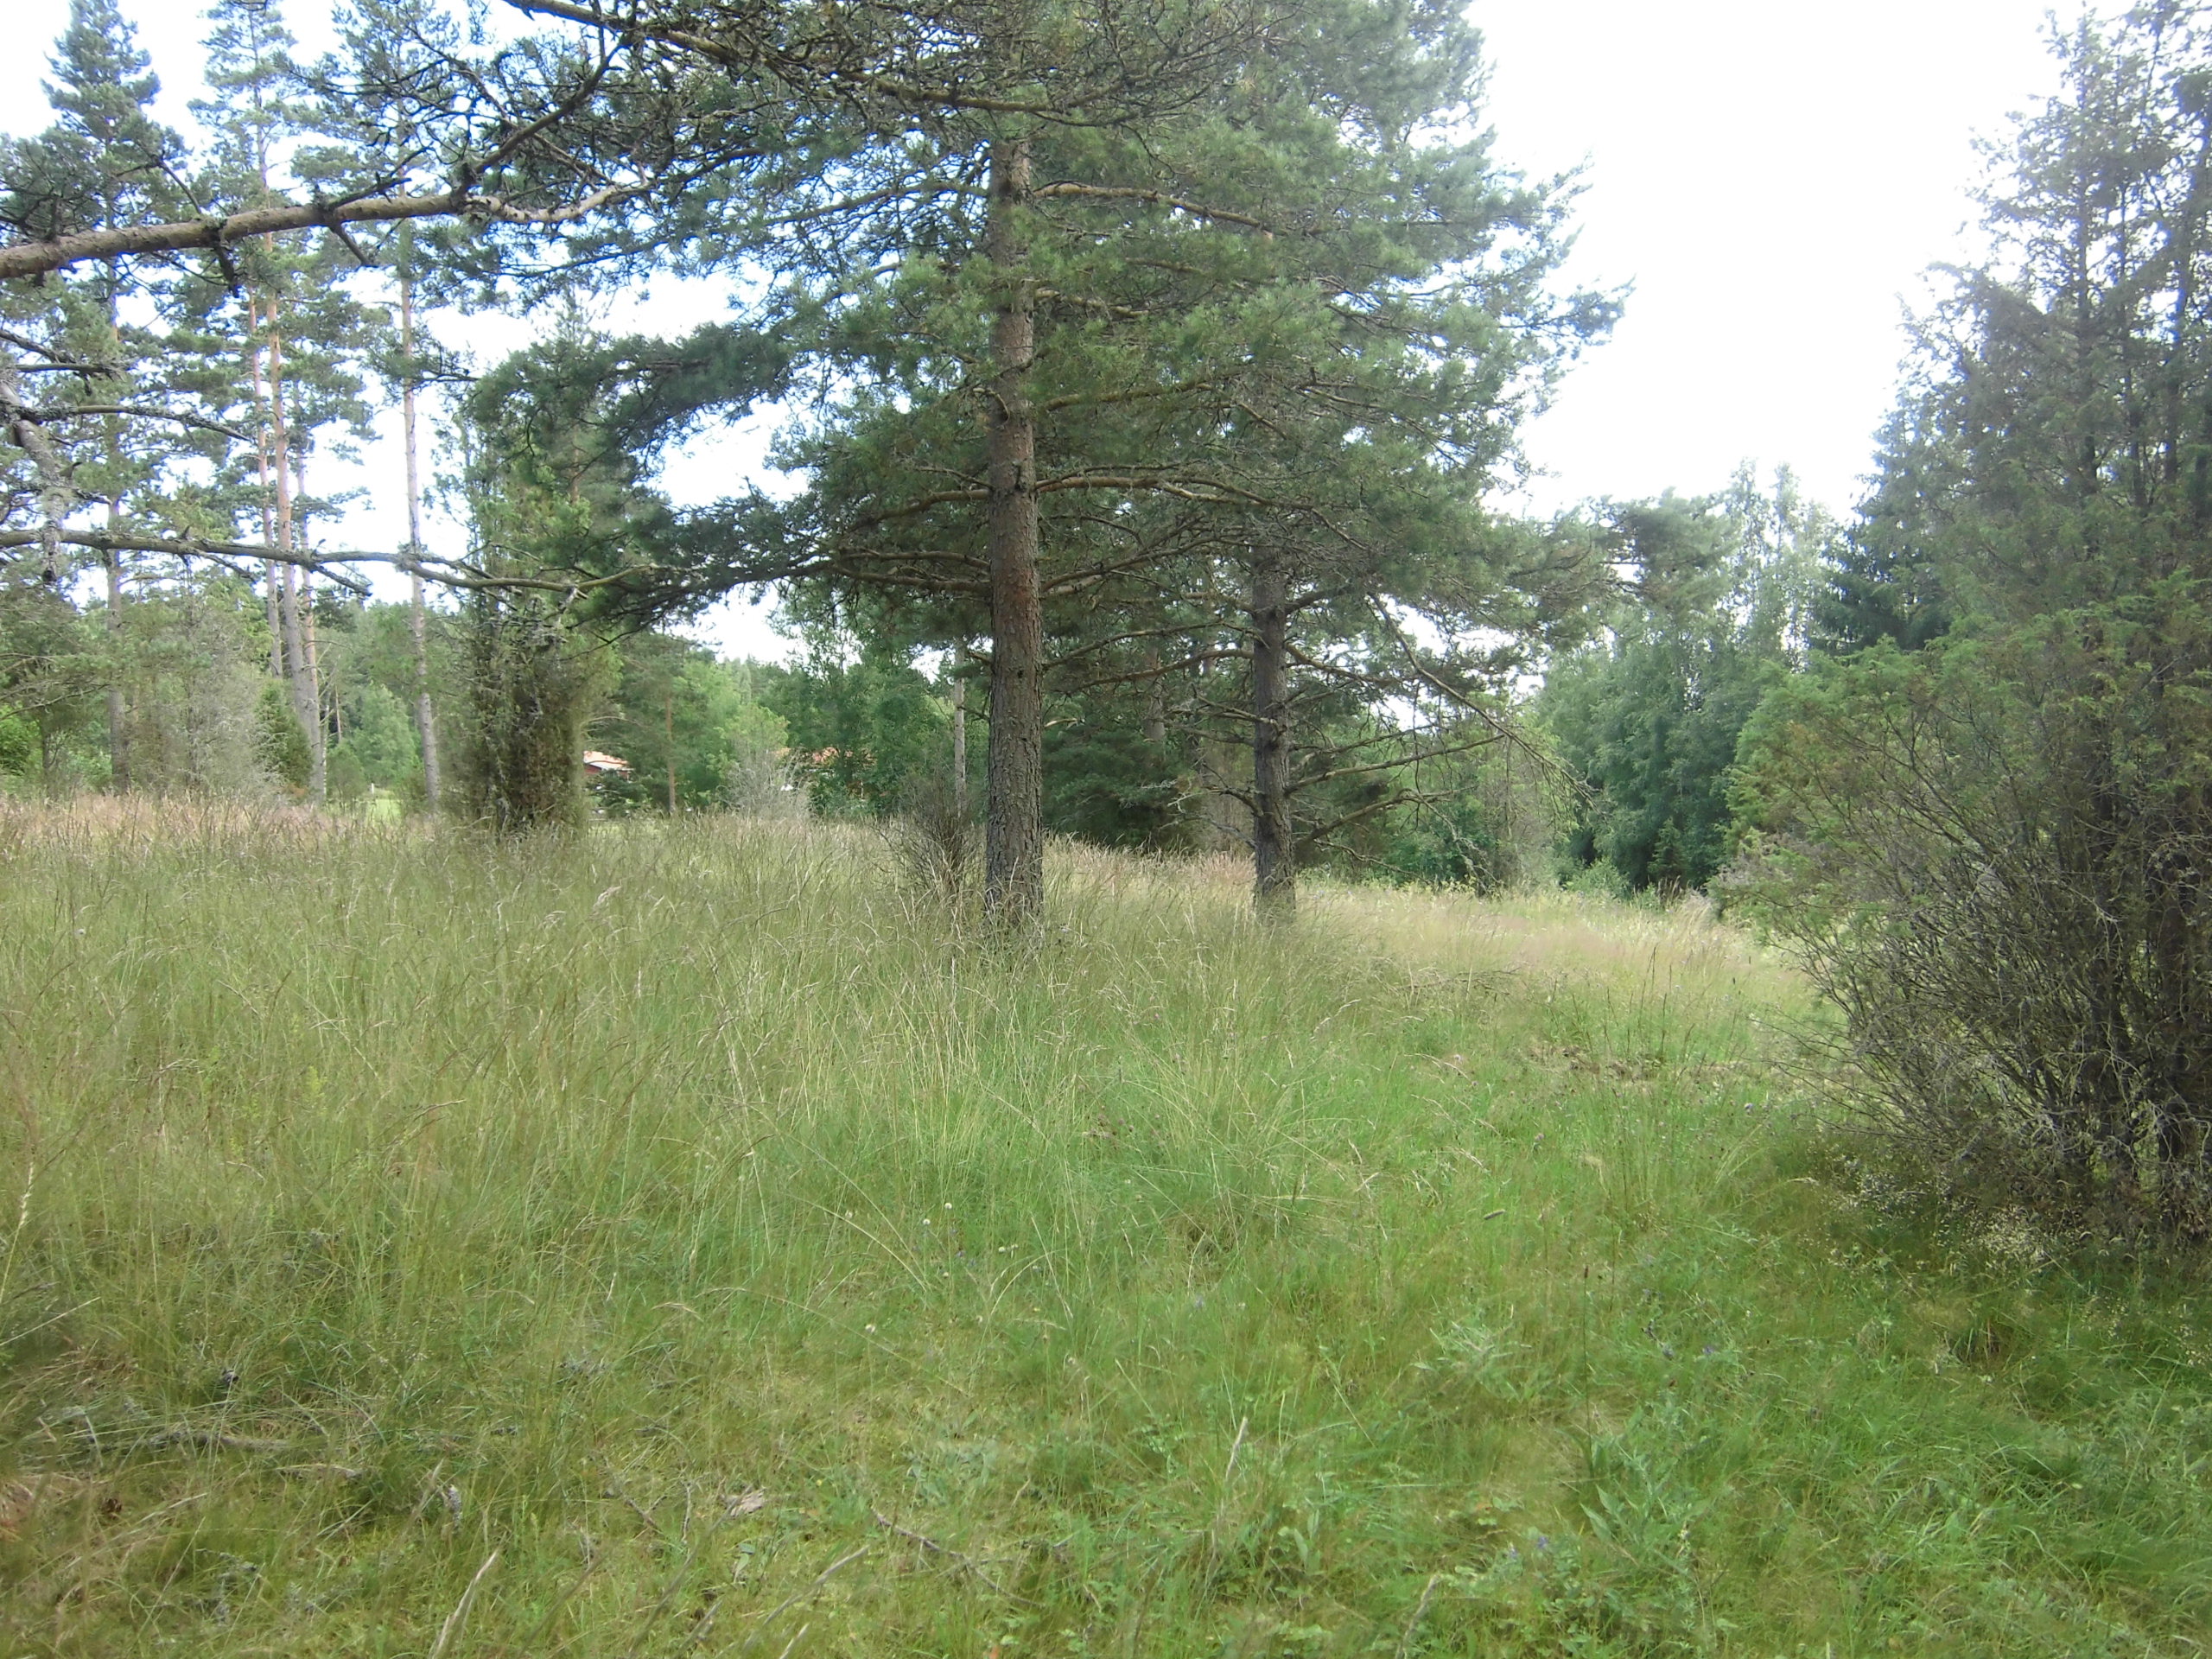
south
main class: Woodland
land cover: Pine dominated coniferous woodland
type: boreal forest
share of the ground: 25 - 50 %
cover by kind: herbaceous plants 40 %, coniferous forest trees 30 %, shrubs 20 %, broadleaved forest trees 5 %, lichens and mosses 5 %
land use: Forestry
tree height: > 5 m
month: July
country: SE
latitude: 57.4310
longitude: 15.2765
